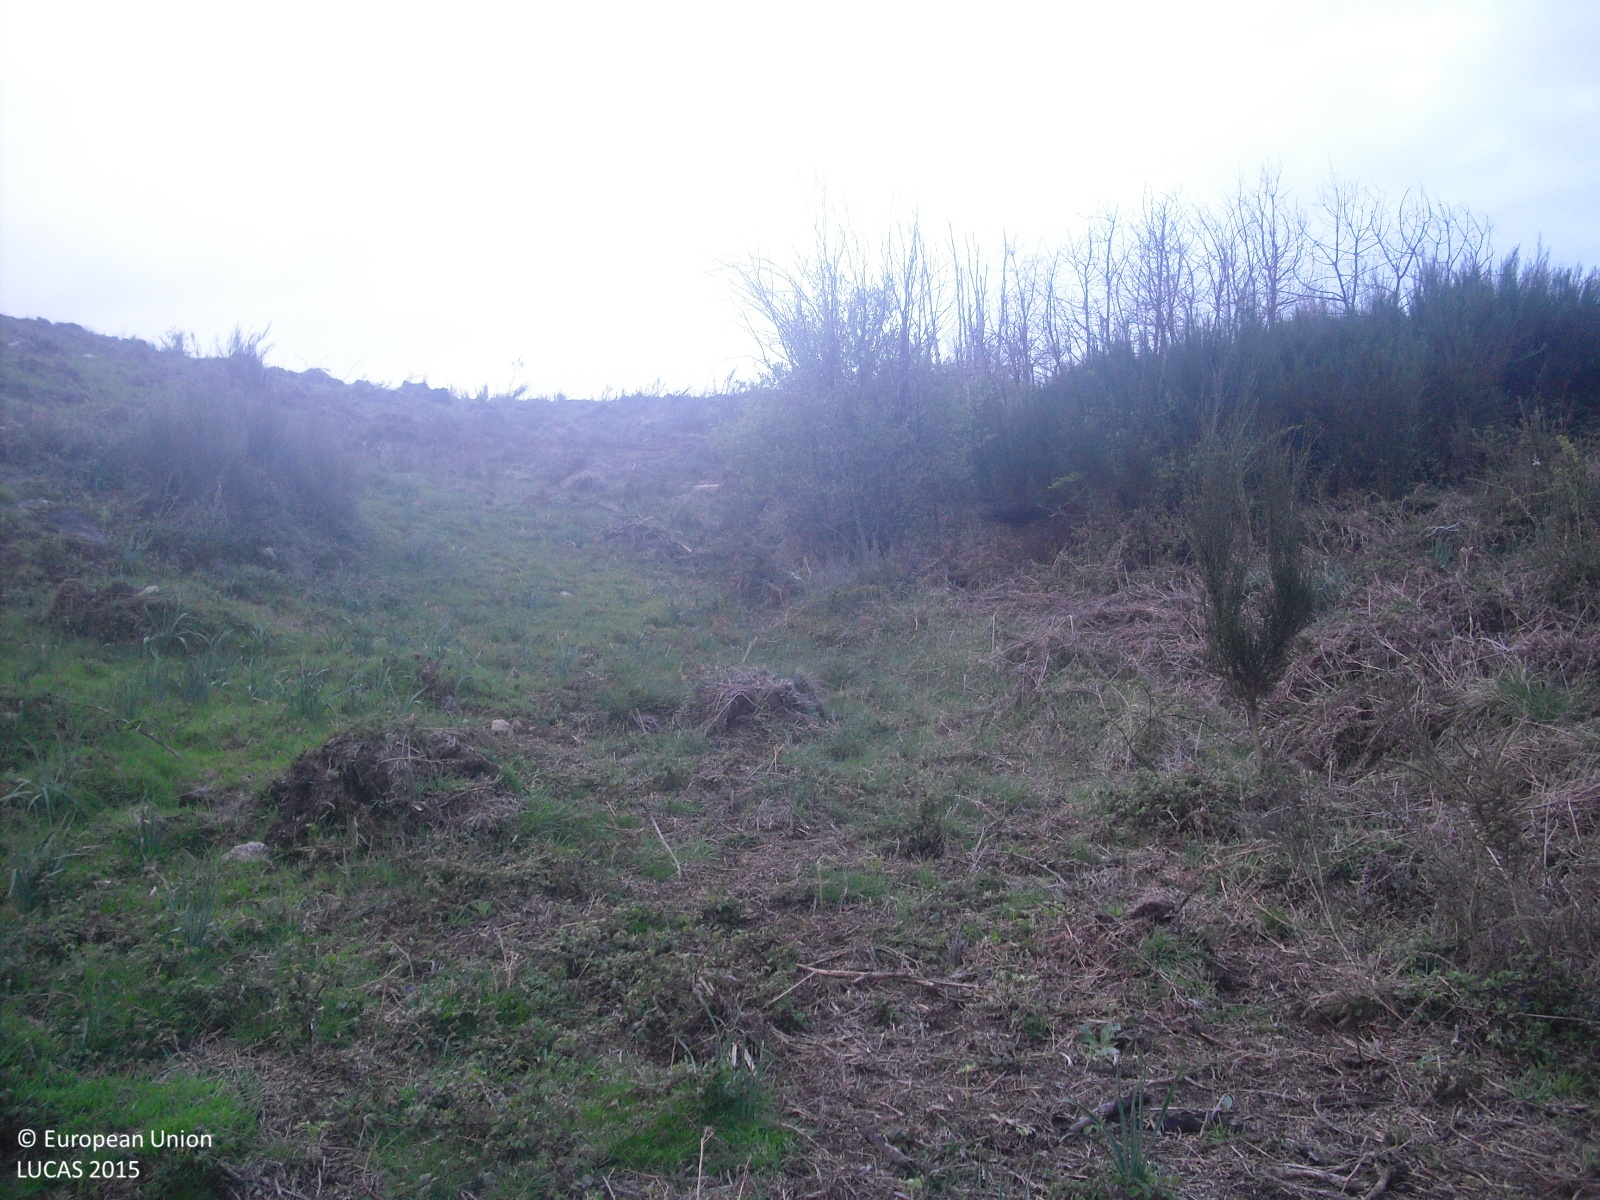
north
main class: Grassland
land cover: Grassland with sparse tree/shrub cover
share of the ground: 50 - 75 %
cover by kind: herbaceous plants 85 %, shrubs 10 %, coniferous forest trees 5 %
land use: Forestry
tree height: < 5 m
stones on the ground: < 10 %
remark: Burnt area
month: April
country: ES
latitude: 42.0418
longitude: -7.8928
